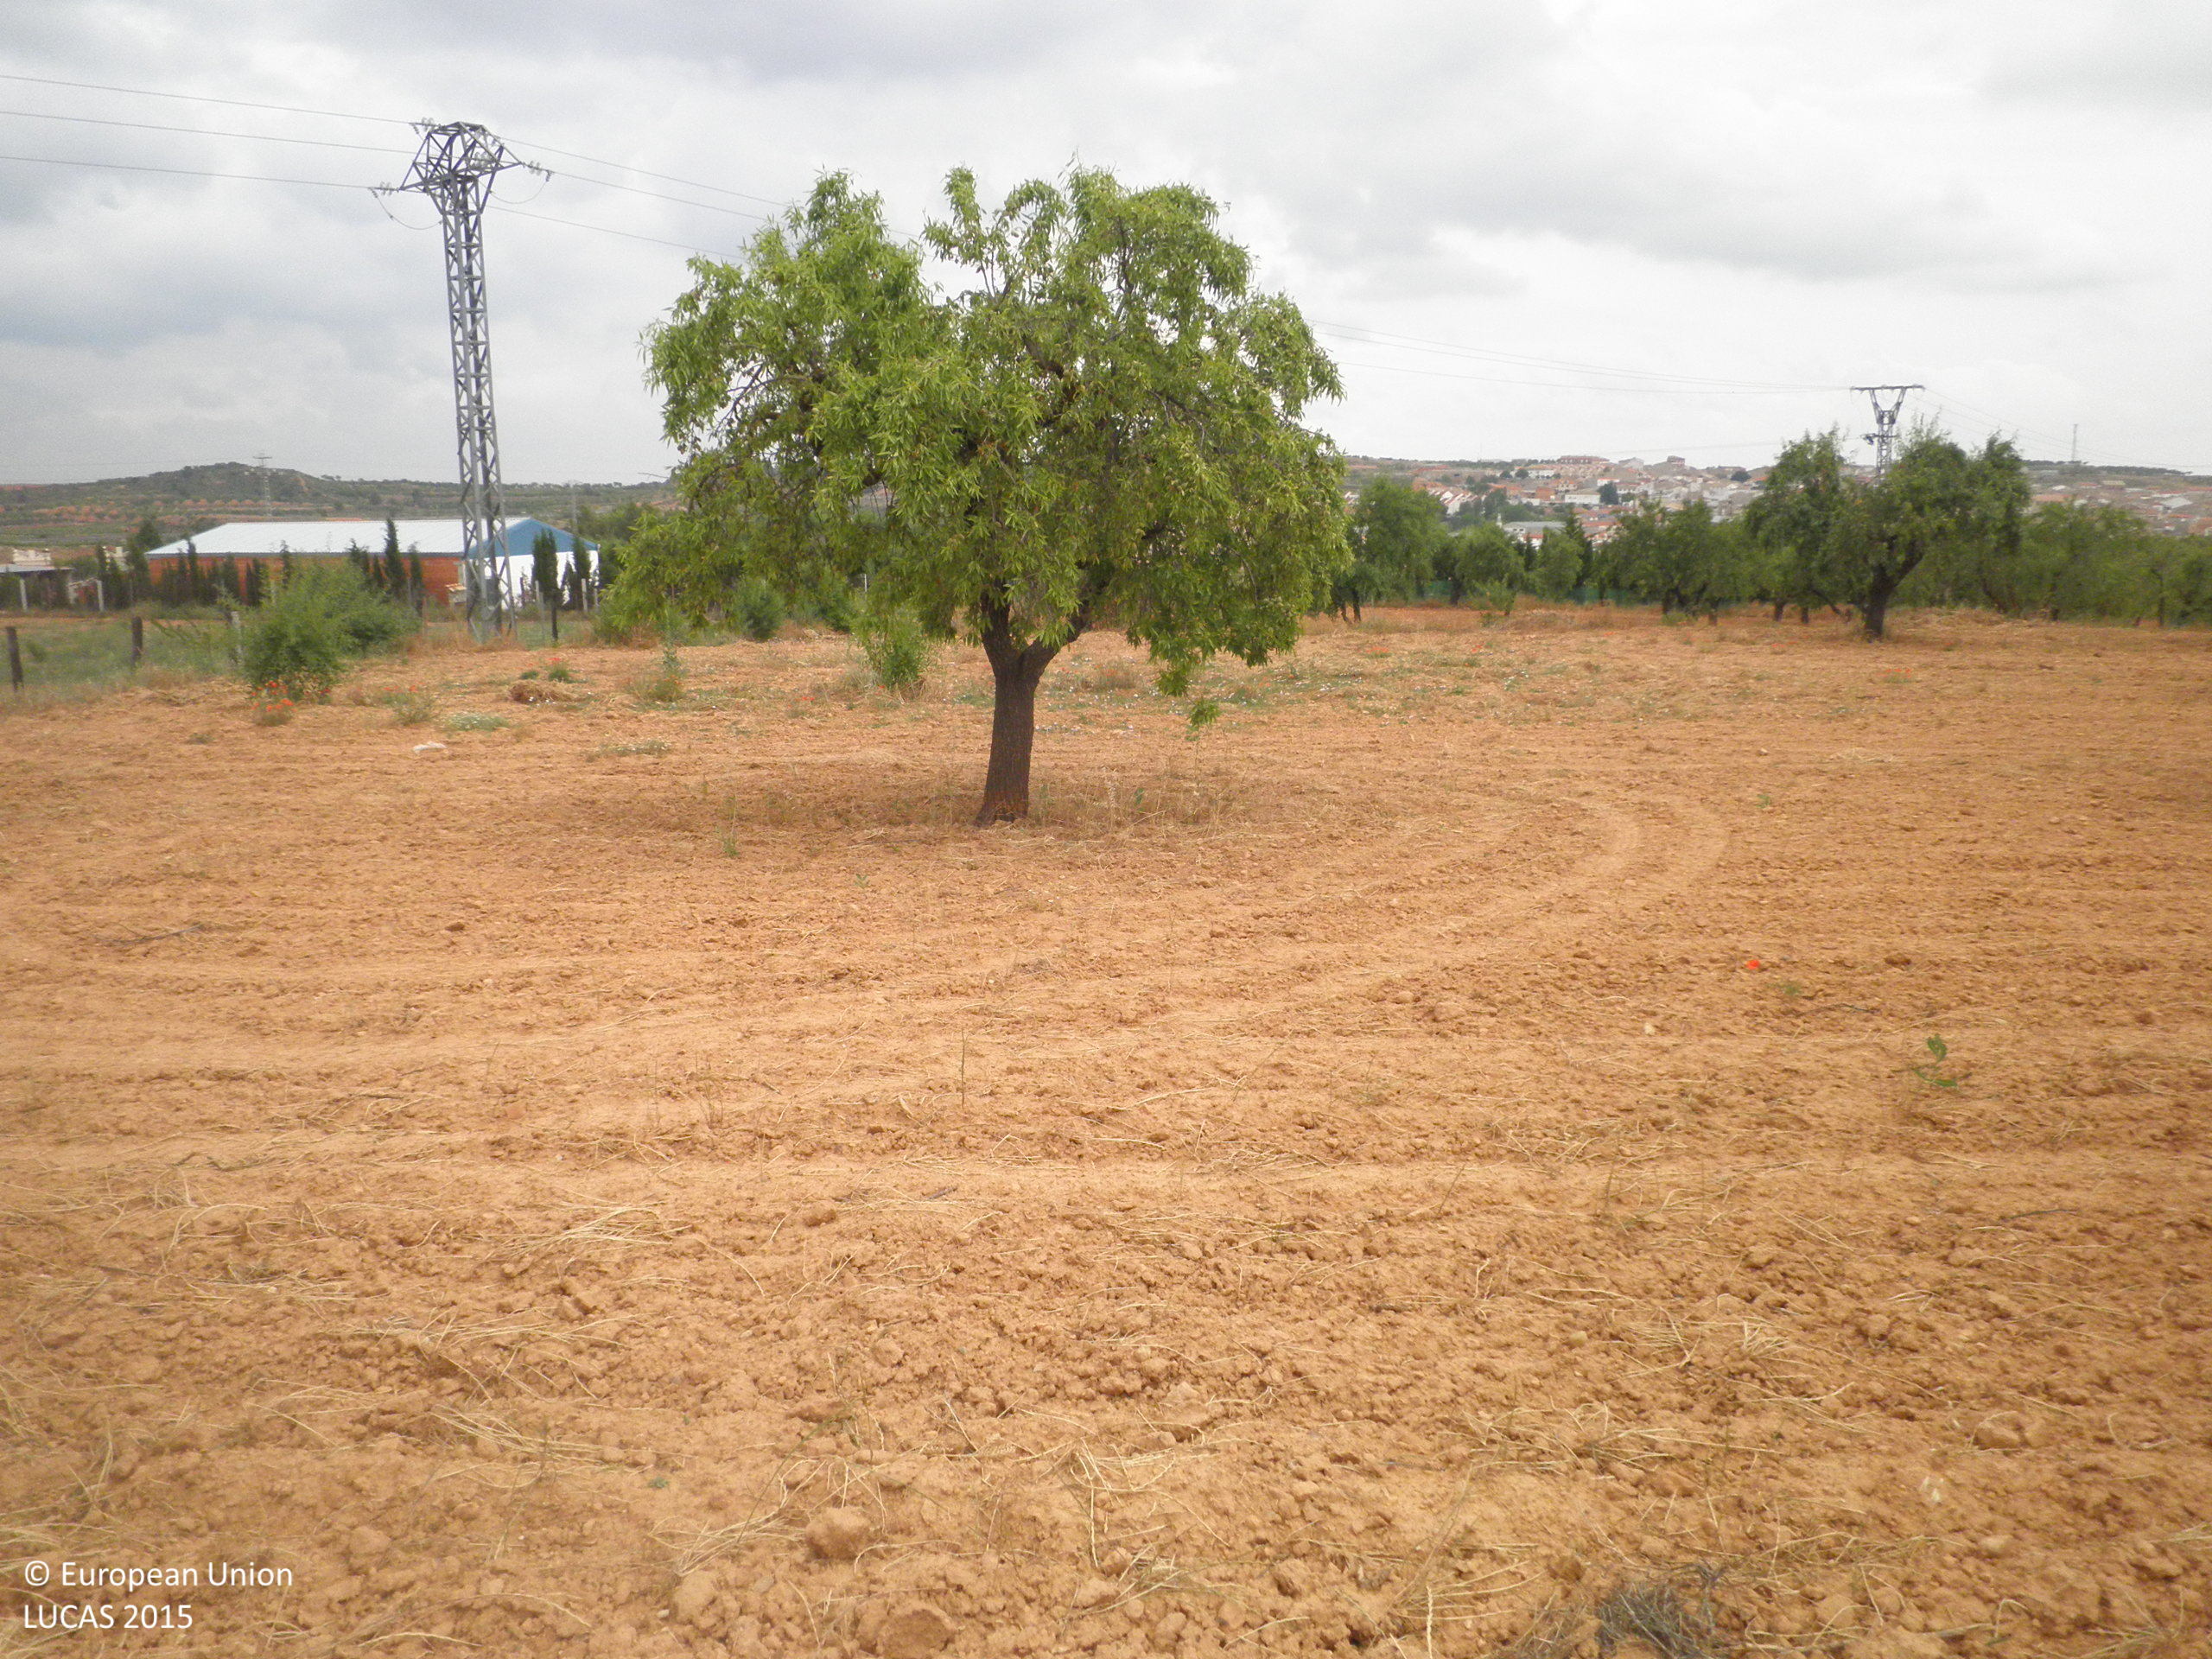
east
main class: Cropland
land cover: Nuts trees
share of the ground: < 10 %
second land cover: Other bare soil
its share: > 75 %
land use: Agriculture (excluding fallow land and kitchen gardens)
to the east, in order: Nuts trees; Other bare soil; Dry stone walls; Grass margins; Nuts trees; Grass margins; Fences; Artificial constructions in urban areas; Fences; Dry stone walls; Grass margins; Vineyards; Dry stone walls; Grass margins; Vineyards; Lines of trees; Dry stone walls; Vineyards; Dry stone walls; Grass margins; Paved roads, cycling and walking lanes
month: June
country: ES
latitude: 39.5395
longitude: -1.6059
